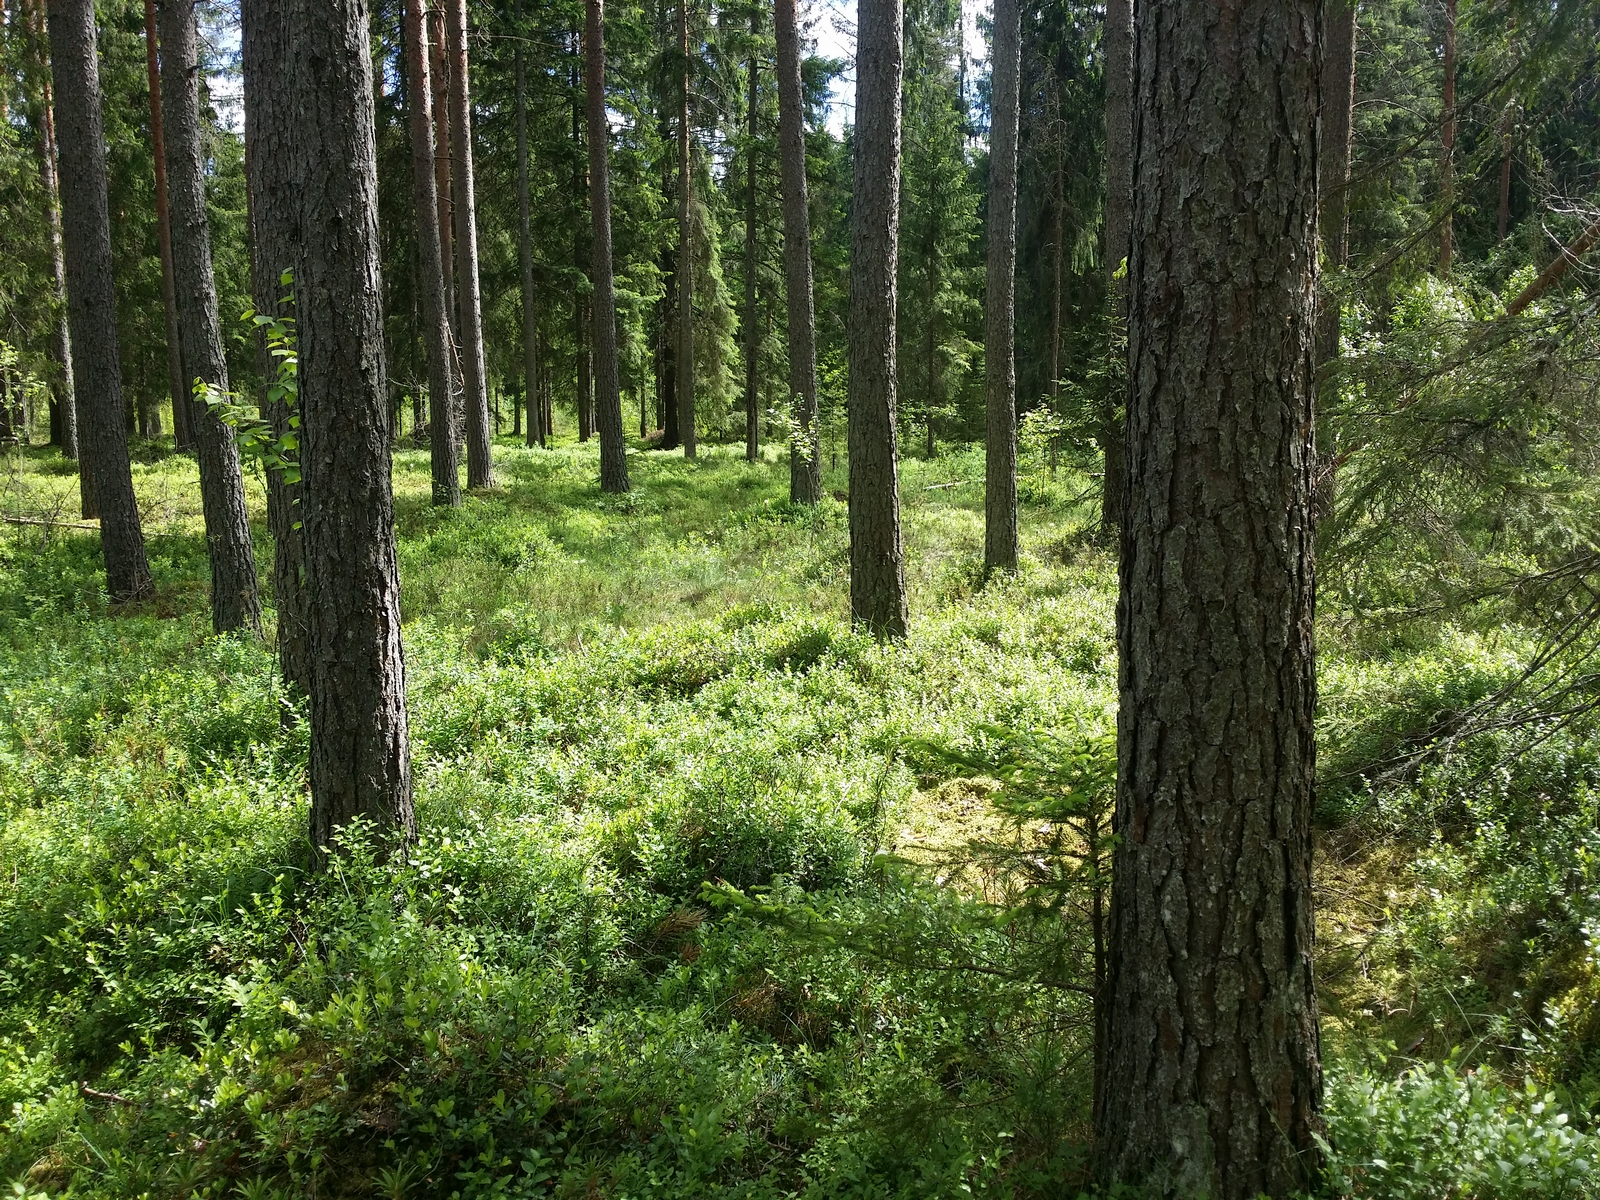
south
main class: Woodland
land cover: Other coniferous woodland
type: hemiboreal forest and nemoral coniferous forest and mixed broadleaved-coniferous forest
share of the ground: 50 - 75 %
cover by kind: coniferous forest trees 65 %, lichens and mosses 25 %, herbaceous plants 10 %
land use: Forestry
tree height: > 5 m
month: June
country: LV
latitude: 57.2869
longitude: 26.4509
